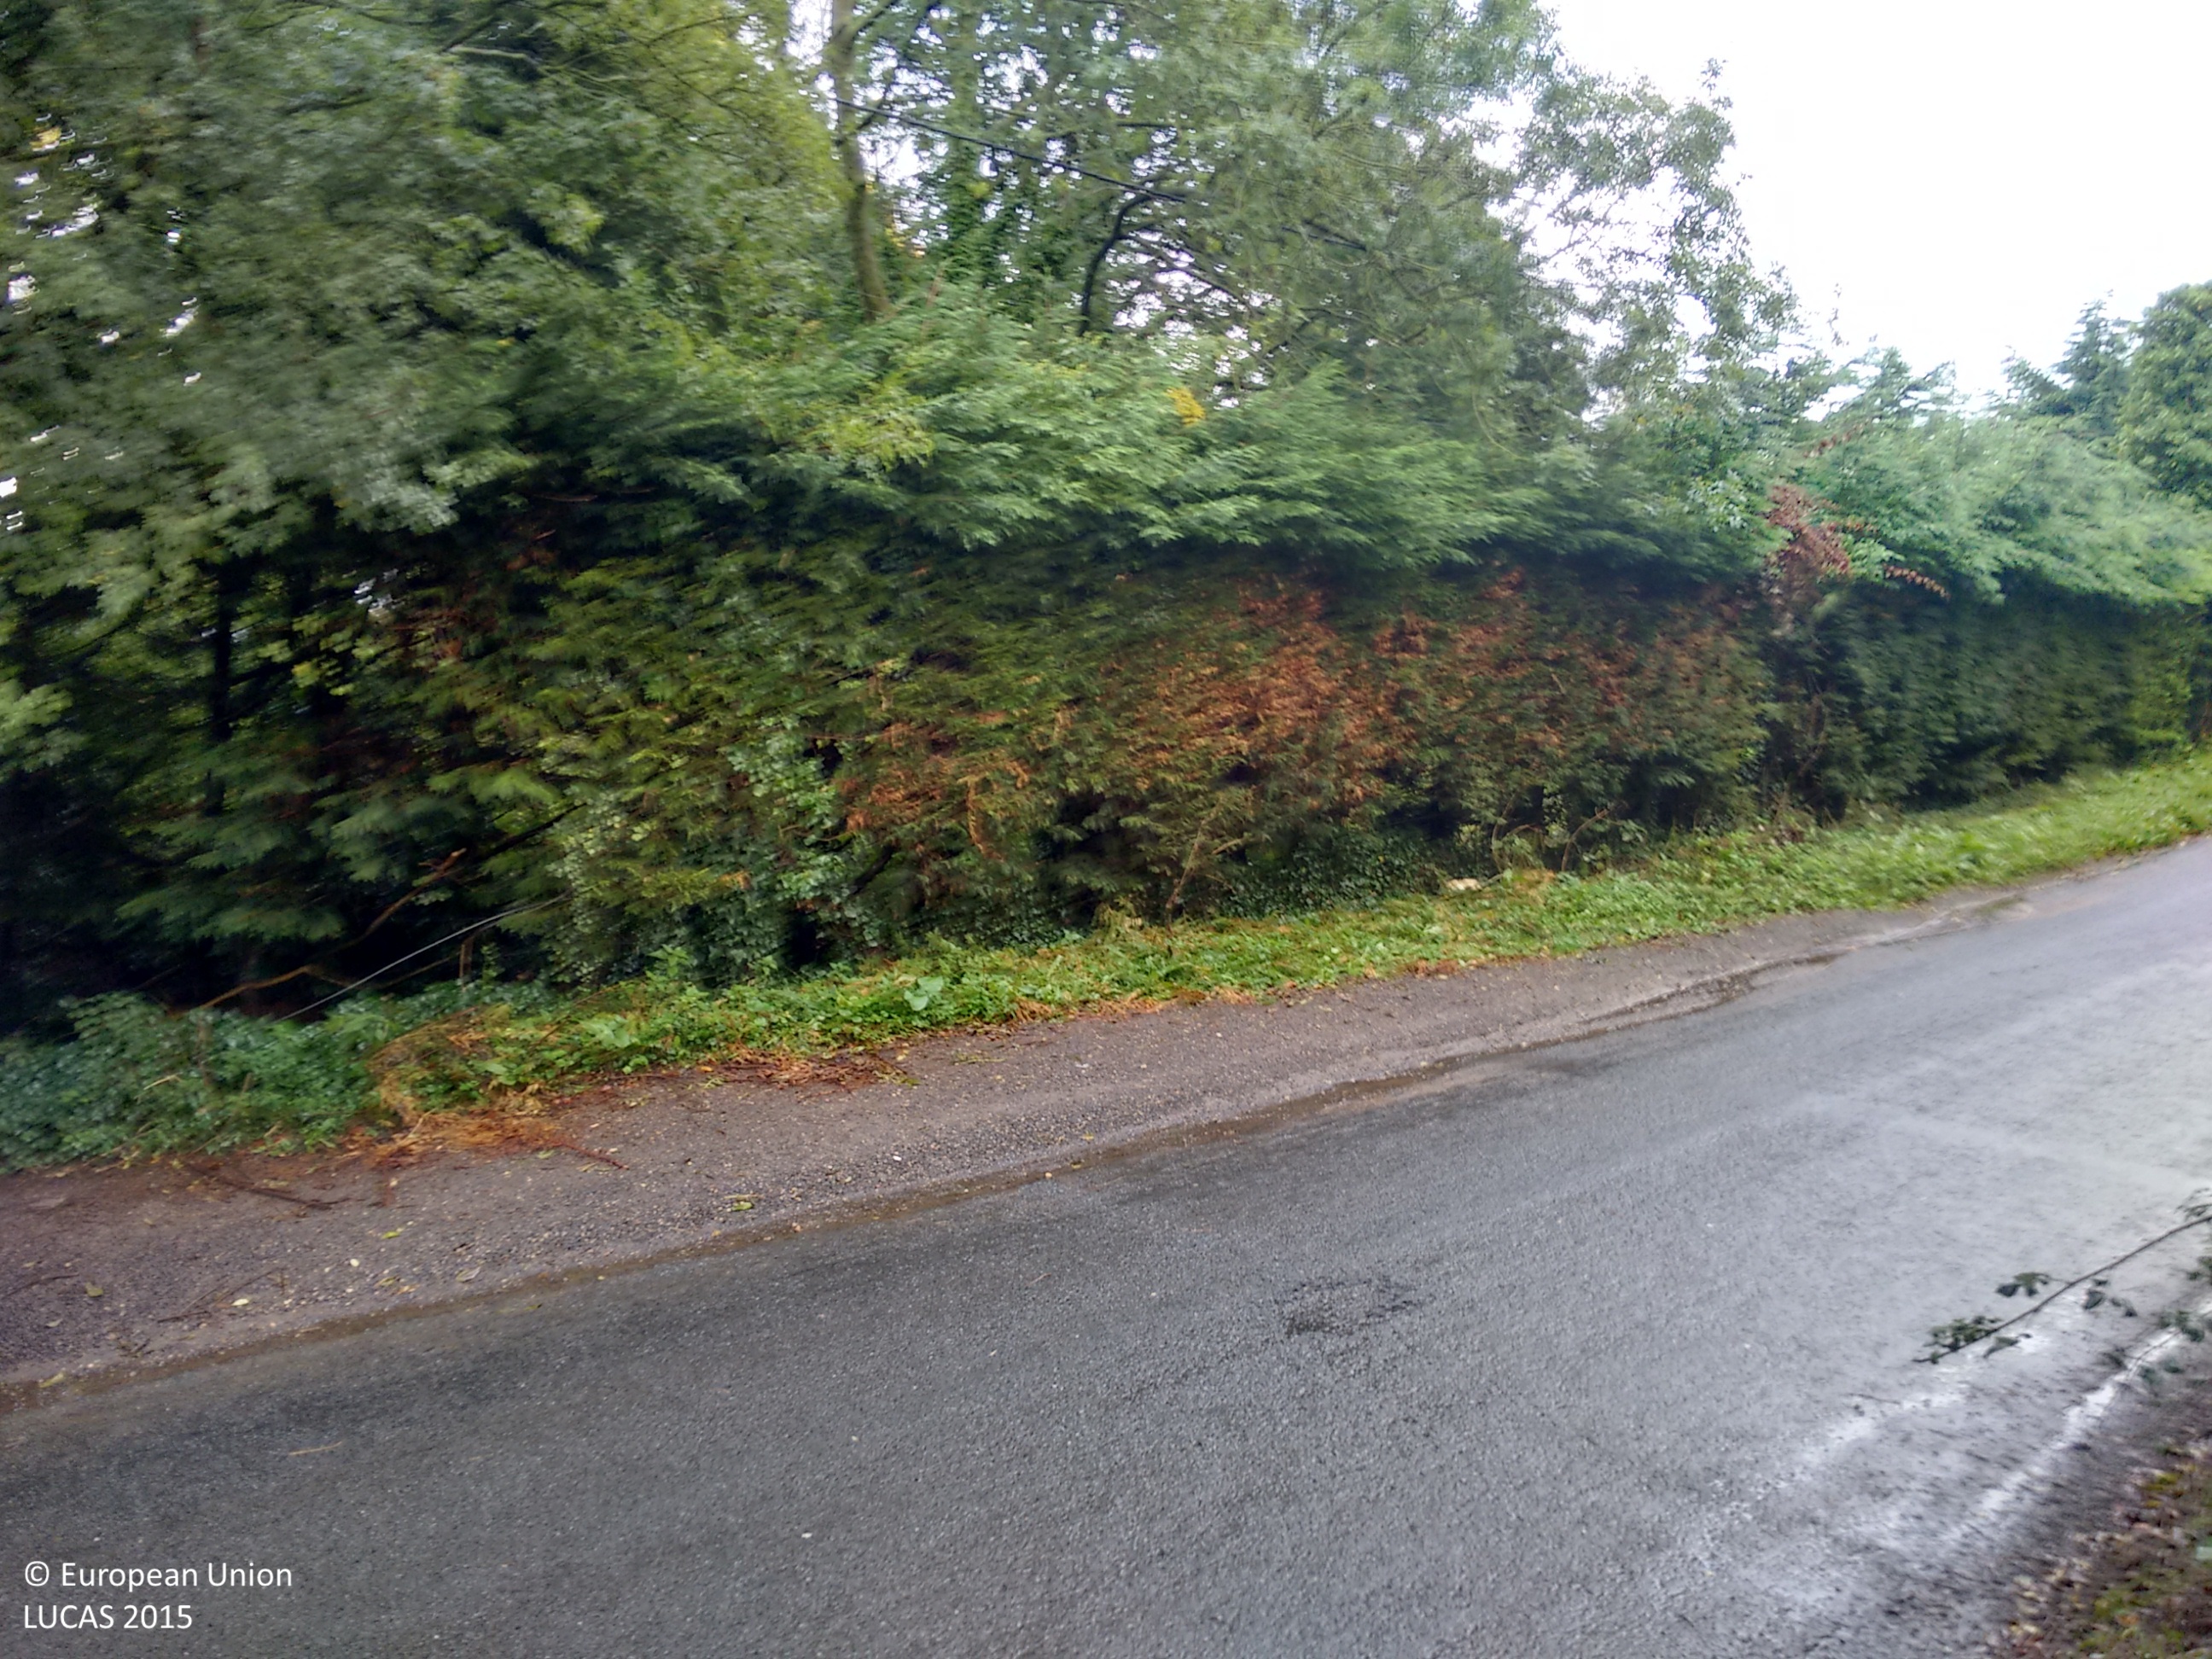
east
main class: Cropland
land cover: Common wheat
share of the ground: 50 - 75 %
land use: Agriculture (excluding fallow land and kitchen gardens)
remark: Harvested field
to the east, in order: Common wheat
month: October
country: GB
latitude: 51.8796
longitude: -1.7783
